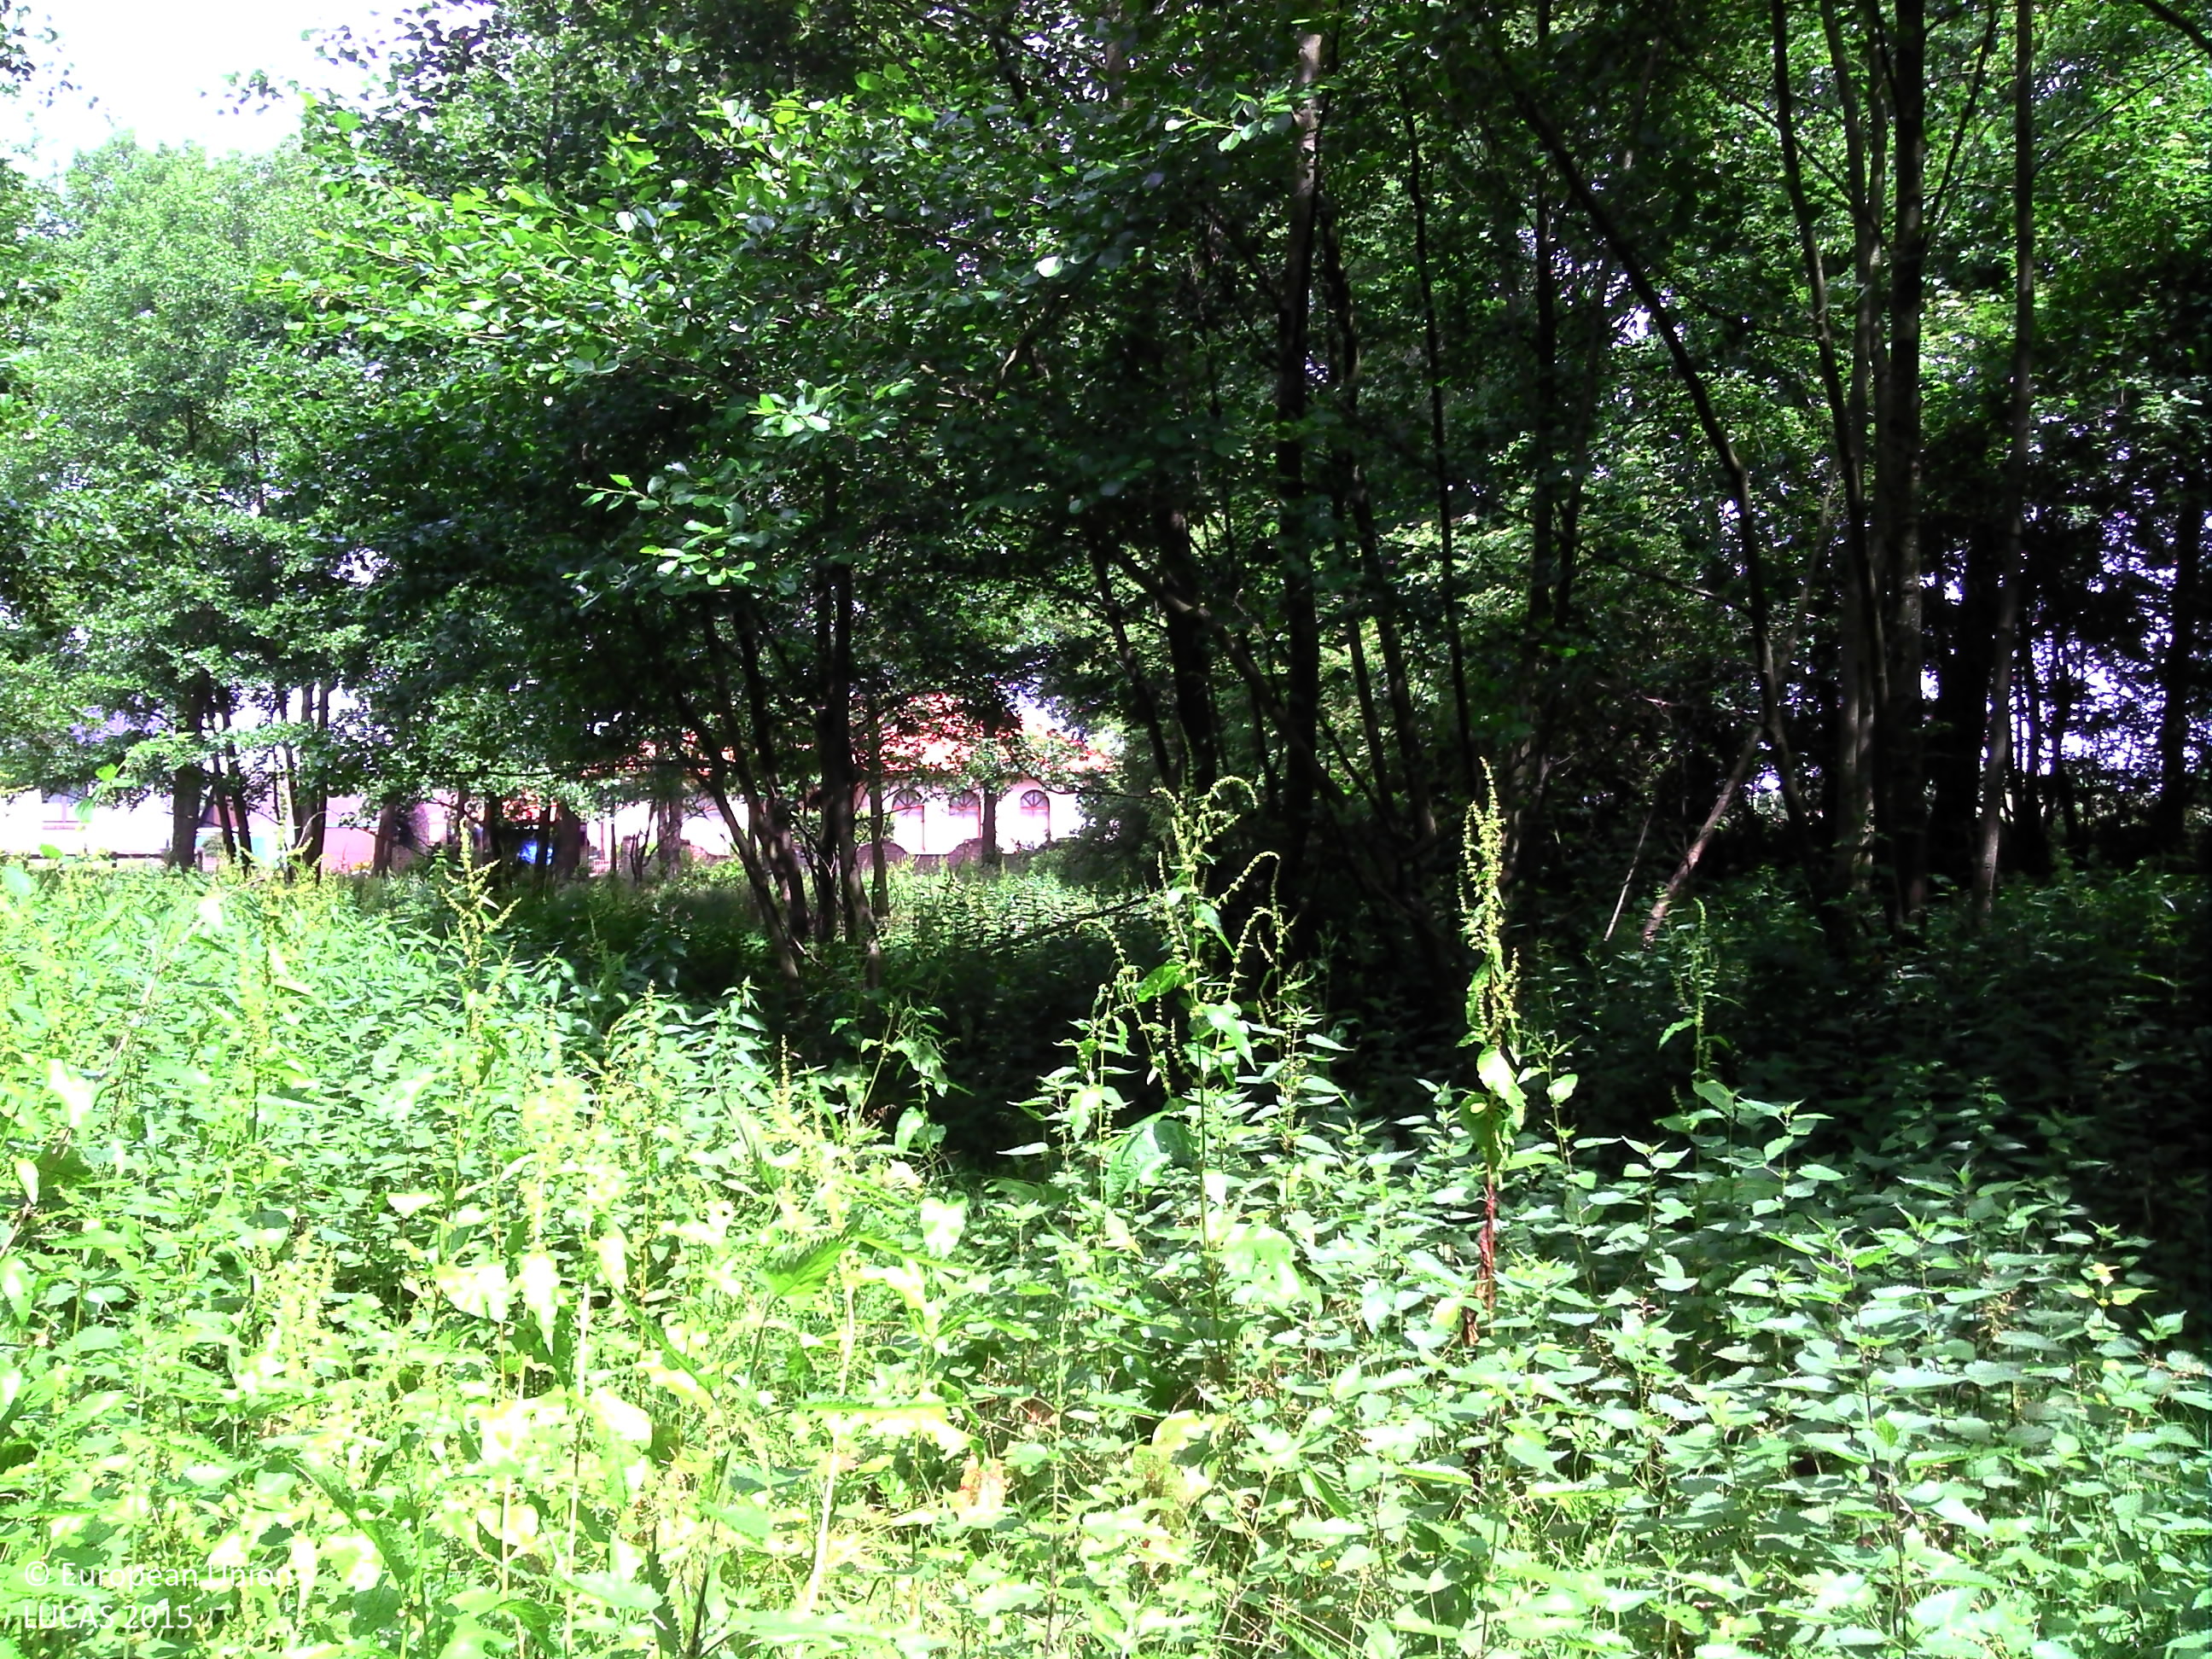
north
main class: Woodland
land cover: Broadleaved woodland
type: non-riverine alder, birch or aspen forest
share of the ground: > 75 %
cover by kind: broadleaved forest trees 60 %, herbaceous plants 40 %
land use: Semi-natural and natural areas not in use
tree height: > 5 m
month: June
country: BE
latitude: 51.1800
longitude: 5.6066
